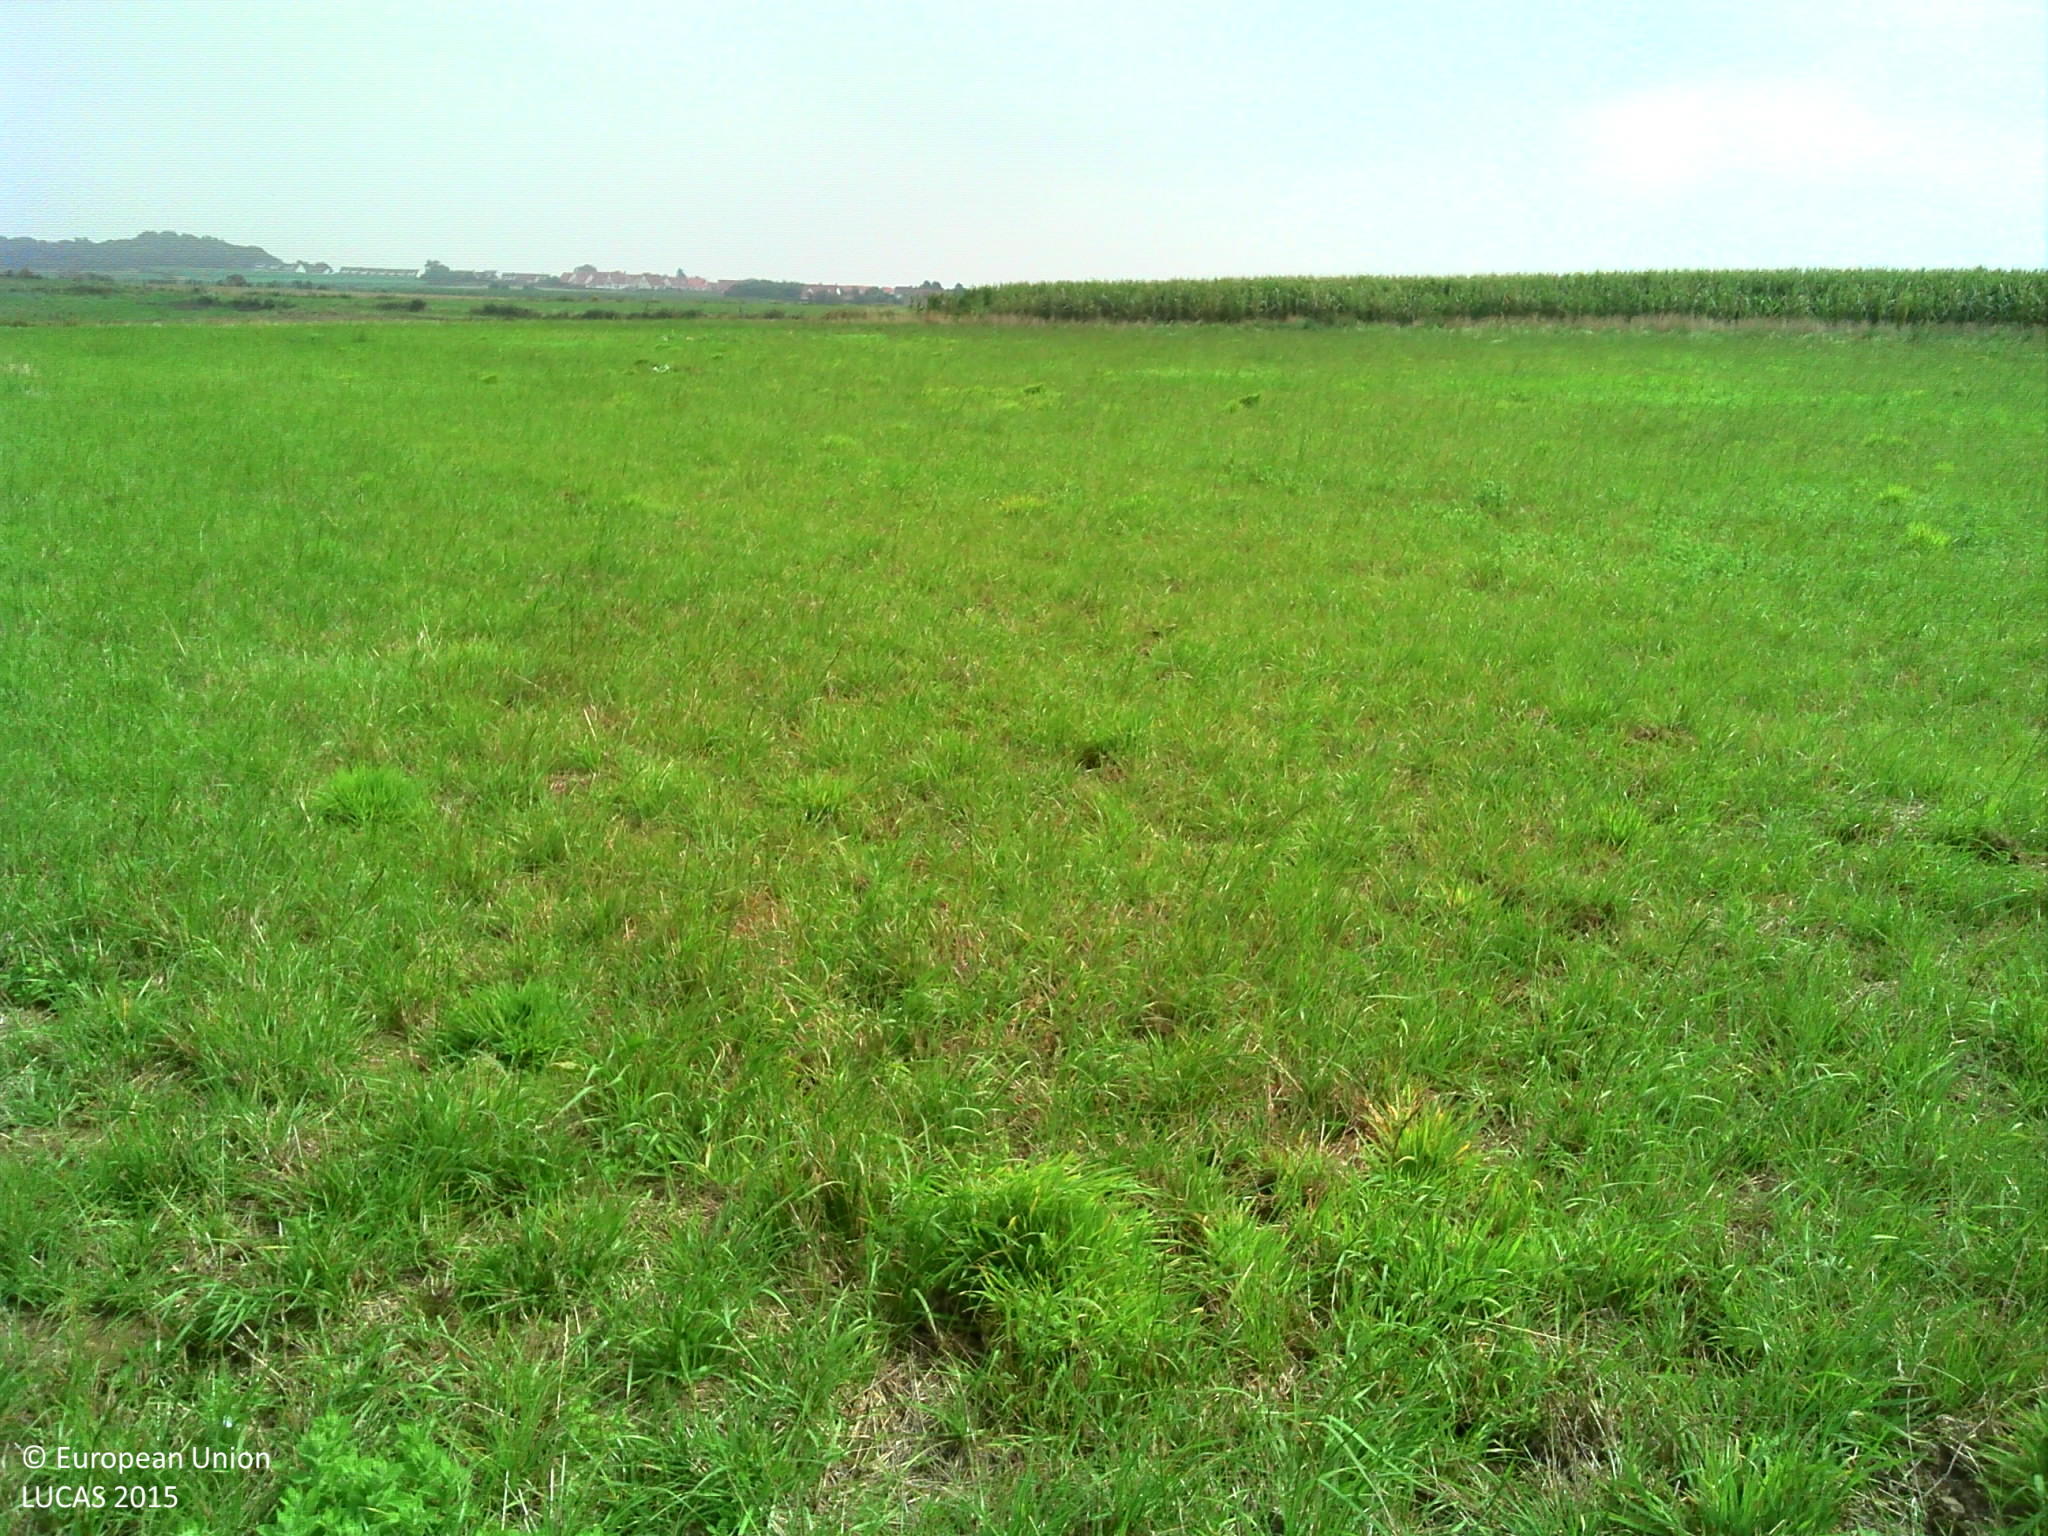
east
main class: Cropland
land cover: Temporary grasslands
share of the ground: > 75 %
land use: Agriculture (excluding fallow land and kitchen gardens)
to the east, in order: Temporary grasslands; Maize; Grass margins; Barley; Temporary grasslands; Grass margins; Fences; Grassland without tree/shrub cover
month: August
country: FR
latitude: 50.6687
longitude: 1.5911
